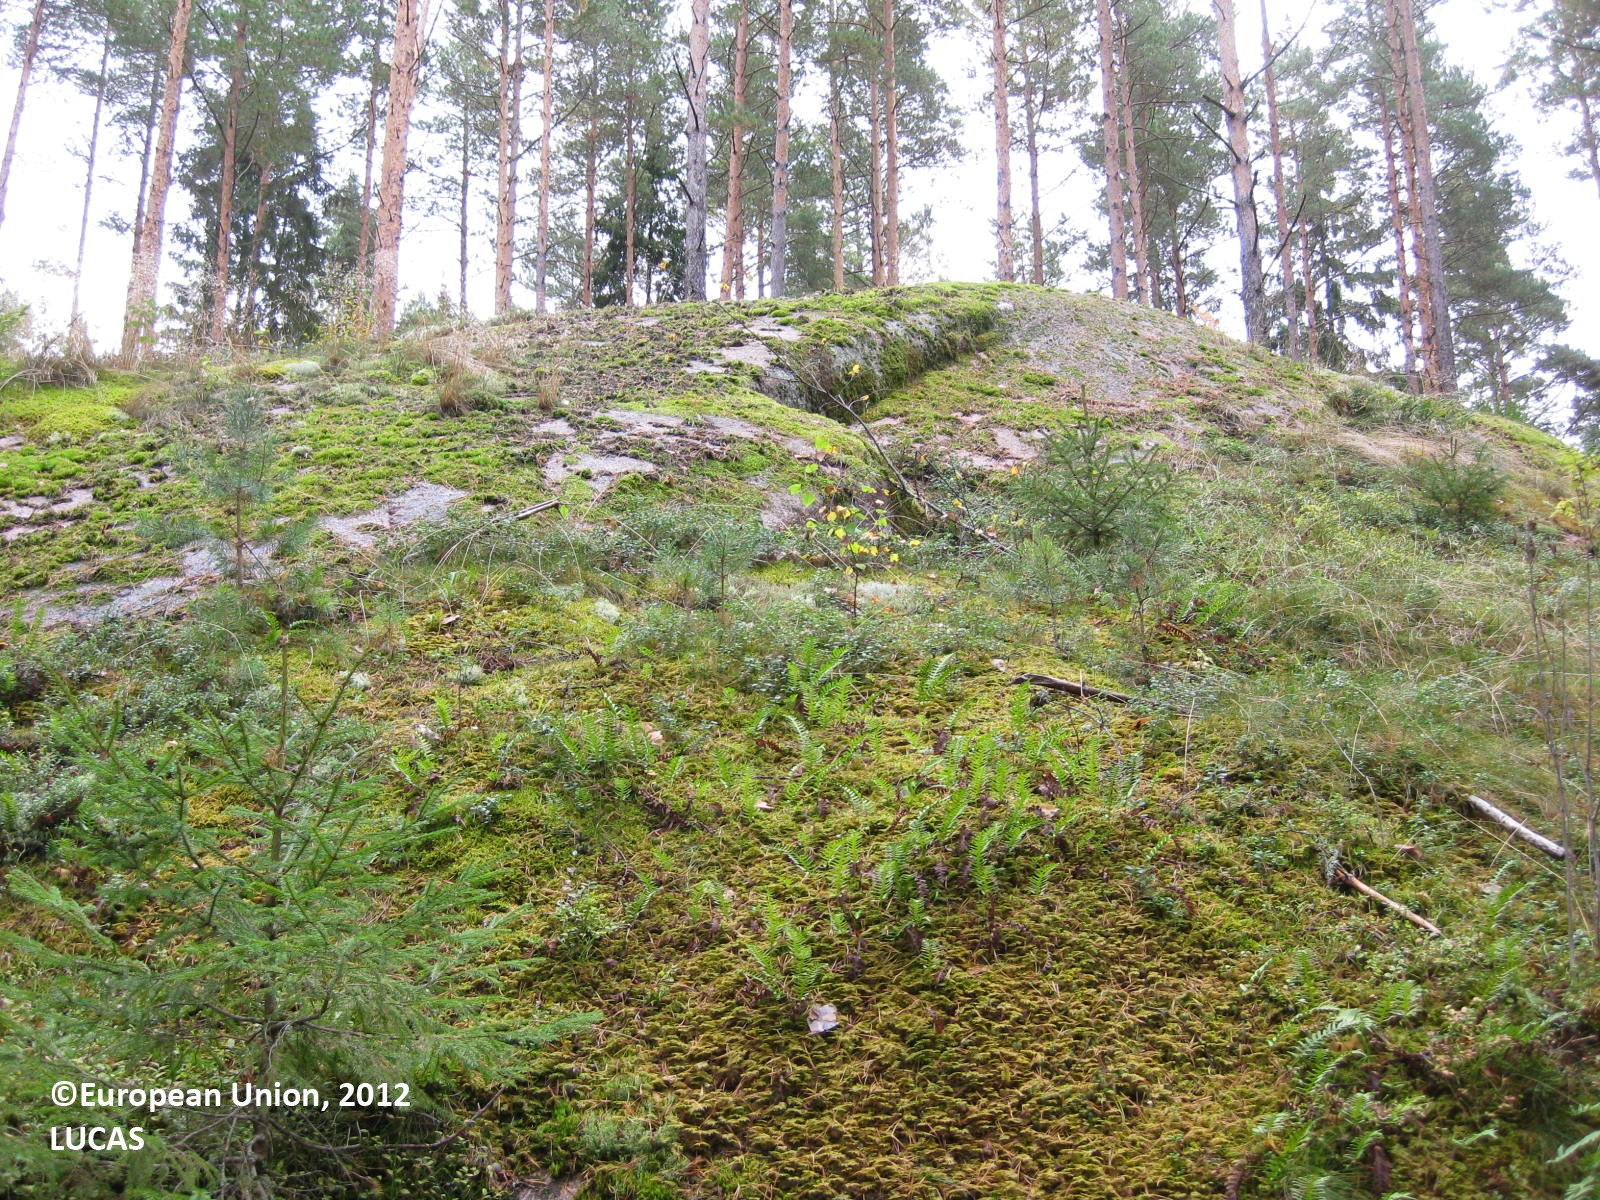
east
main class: Woodland
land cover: Other coniferous woodland
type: boreal forest
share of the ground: 25 - 50 %
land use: Forestry
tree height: > 5 m
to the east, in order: Other coniferous woodland
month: September
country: FI
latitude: 60.3079
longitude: 22.1746
